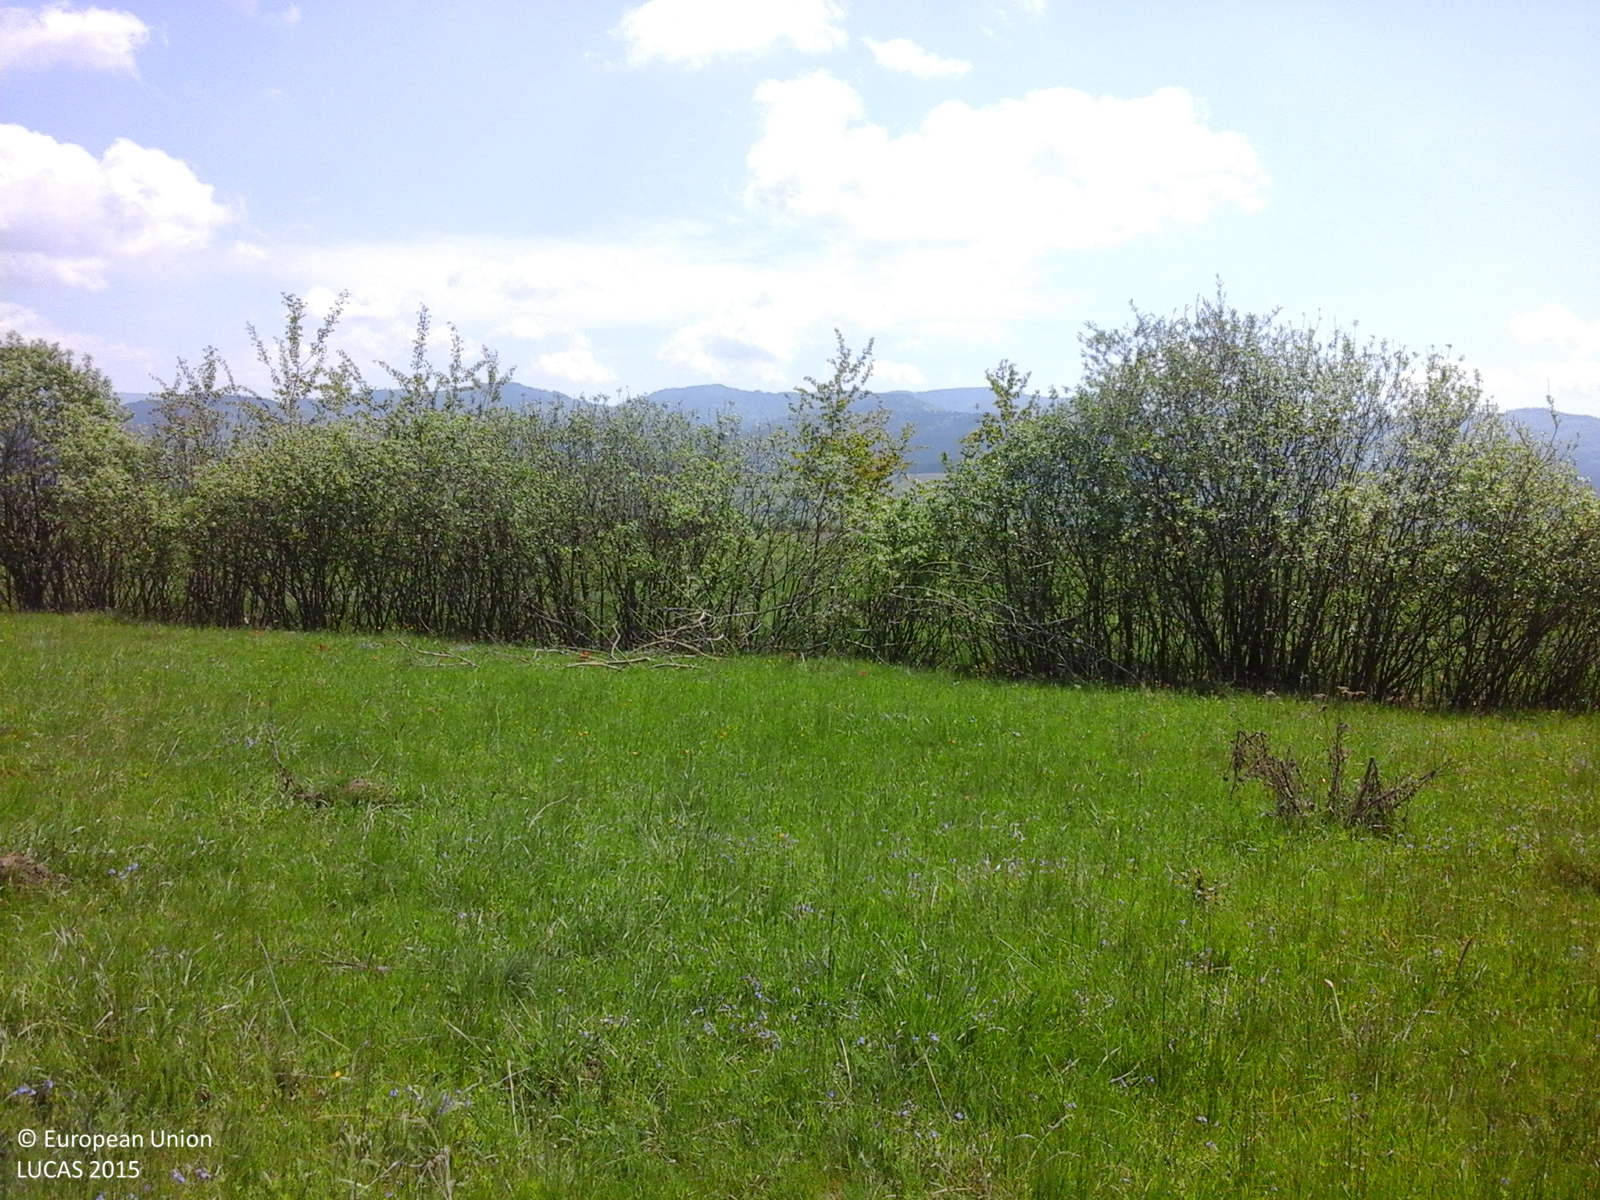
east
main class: Grassland
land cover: Grassland without tree/shrub cover
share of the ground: > 75 %
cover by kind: herbaceous plants 95 %, consolidated bare surface 5 %
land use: Agriculture (excluding fallow land and kitchen gardens)
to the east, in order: Grassland without tree/shrub cover; Lines of trees; Ditches and canals; Grassland without tree/shrub cover; Single bushes/trees; Grassland without tree/shrub cover; Tracks; Grassland without tree/shrub cover
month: May
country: RO
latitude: 45.8164
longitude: 26.1157
